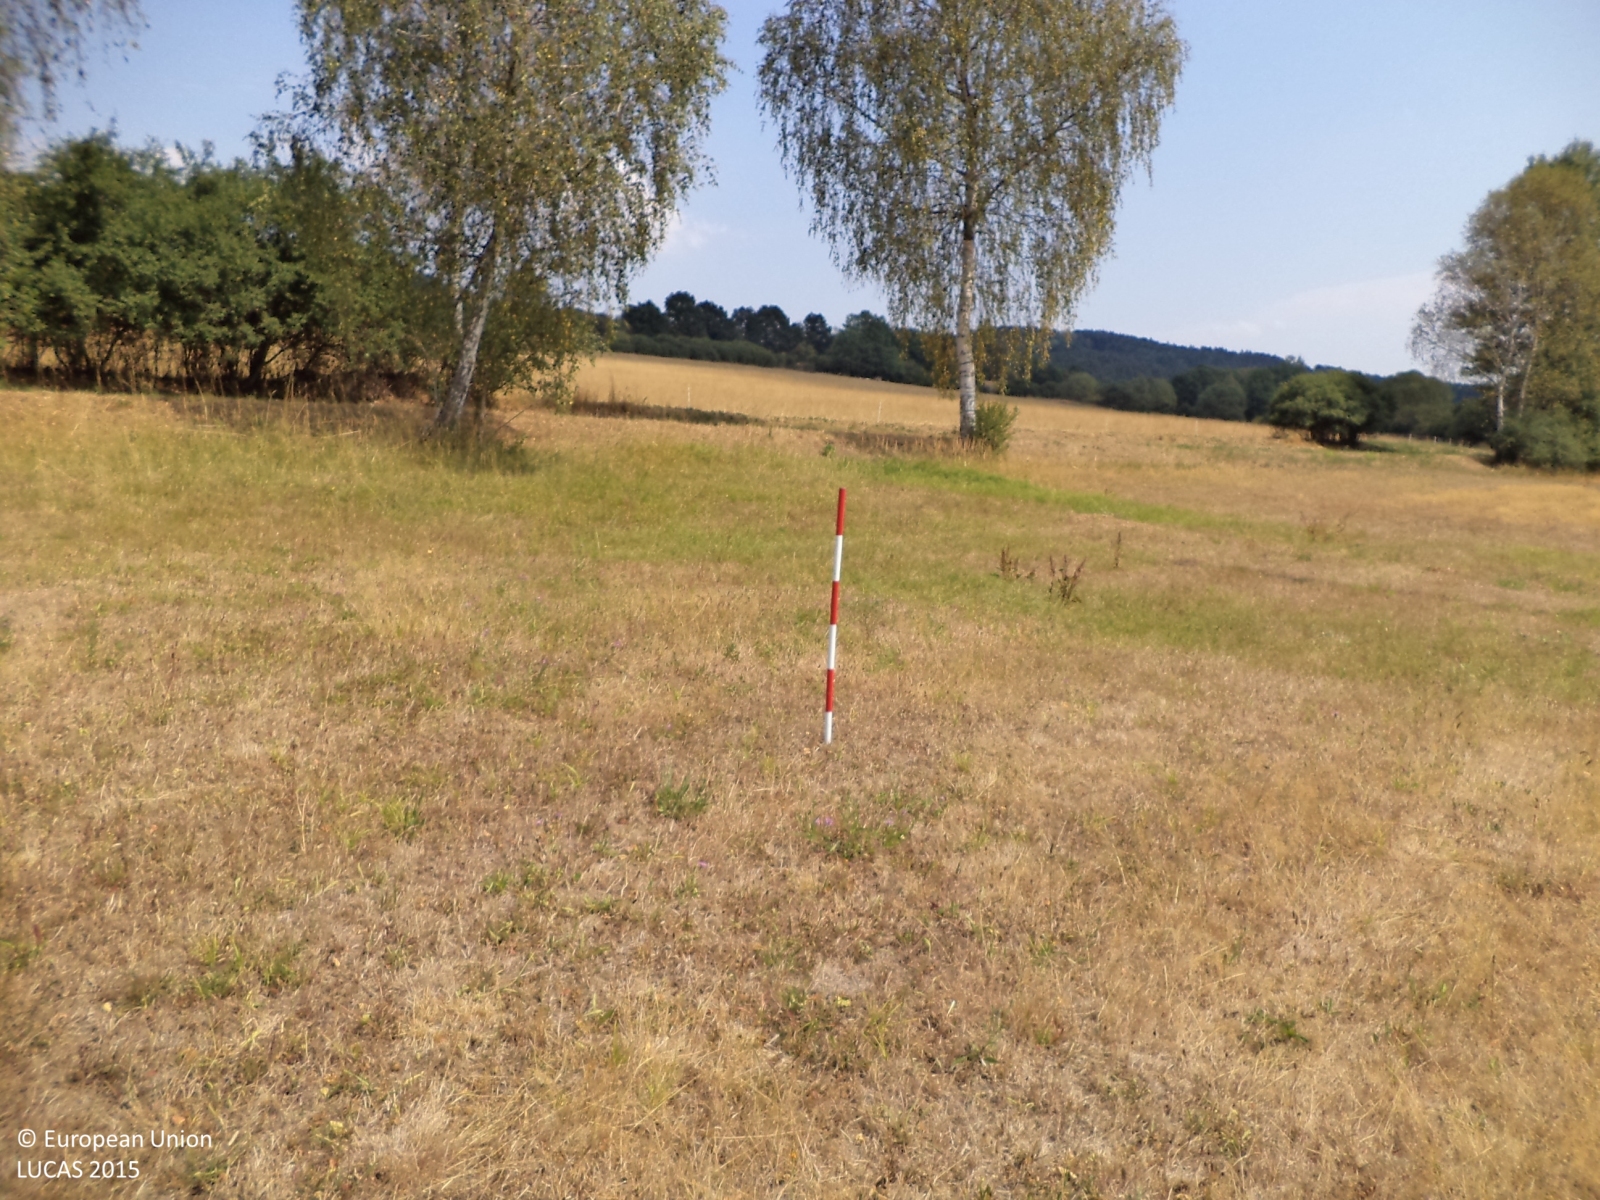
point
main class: Grassland
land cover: Grassland without tree/shrub cover
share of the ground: > 75 %
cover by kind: herbaceous plants 100 %
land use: Agriculture (excluding fallow land and kitchen gardens)
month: August
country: CZ
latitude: 49.4667
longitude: 14.4583
